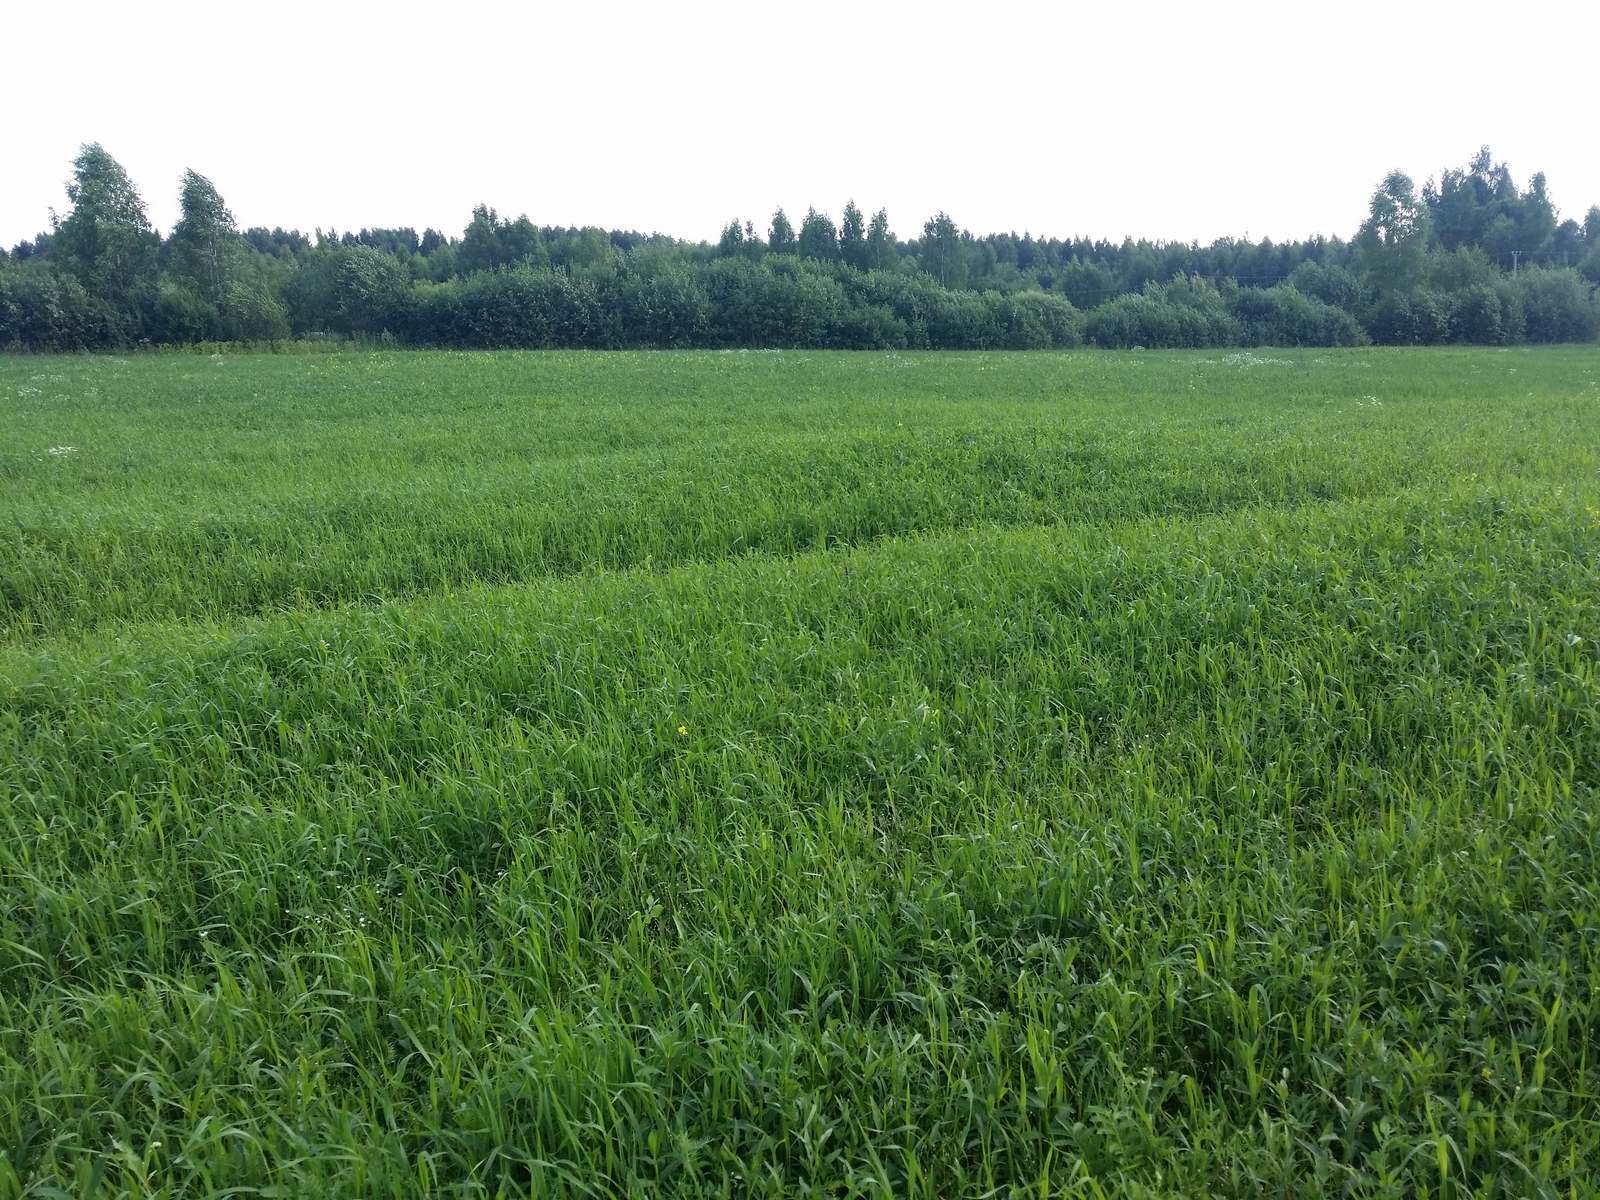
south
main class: Grassland
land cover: Grassland without tree/shrub cover
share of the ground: > 75 %
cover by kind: herbaceous plants 100 %
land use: Agriculture (excluding fallow land and kitchen gardens)
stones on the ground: < 10 %
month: July
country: LV
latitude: 57.2209
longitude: 27.2414
